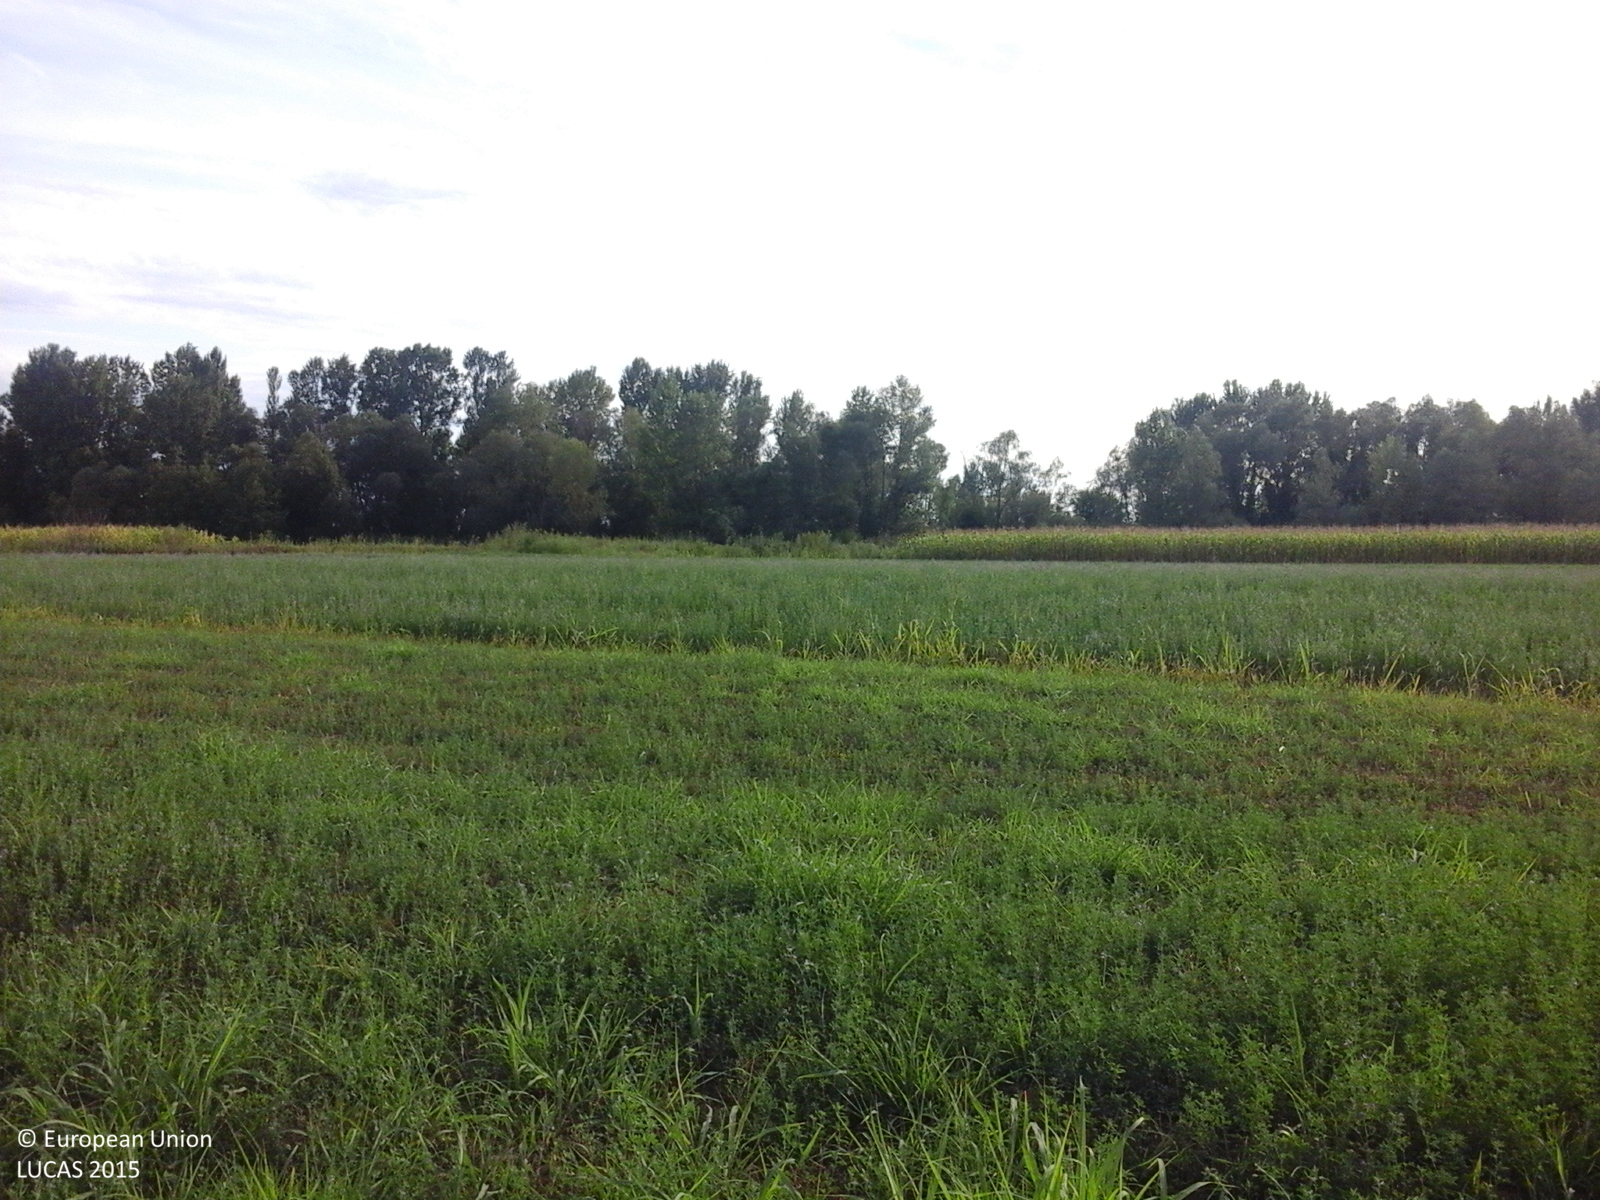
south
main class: Cropland
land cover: Lucerne
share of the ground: > 75 %
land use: Agriculture (excluding fallow land and kitchen gardens)
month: August
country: RO
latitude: 45.1311
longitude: 21.6404
